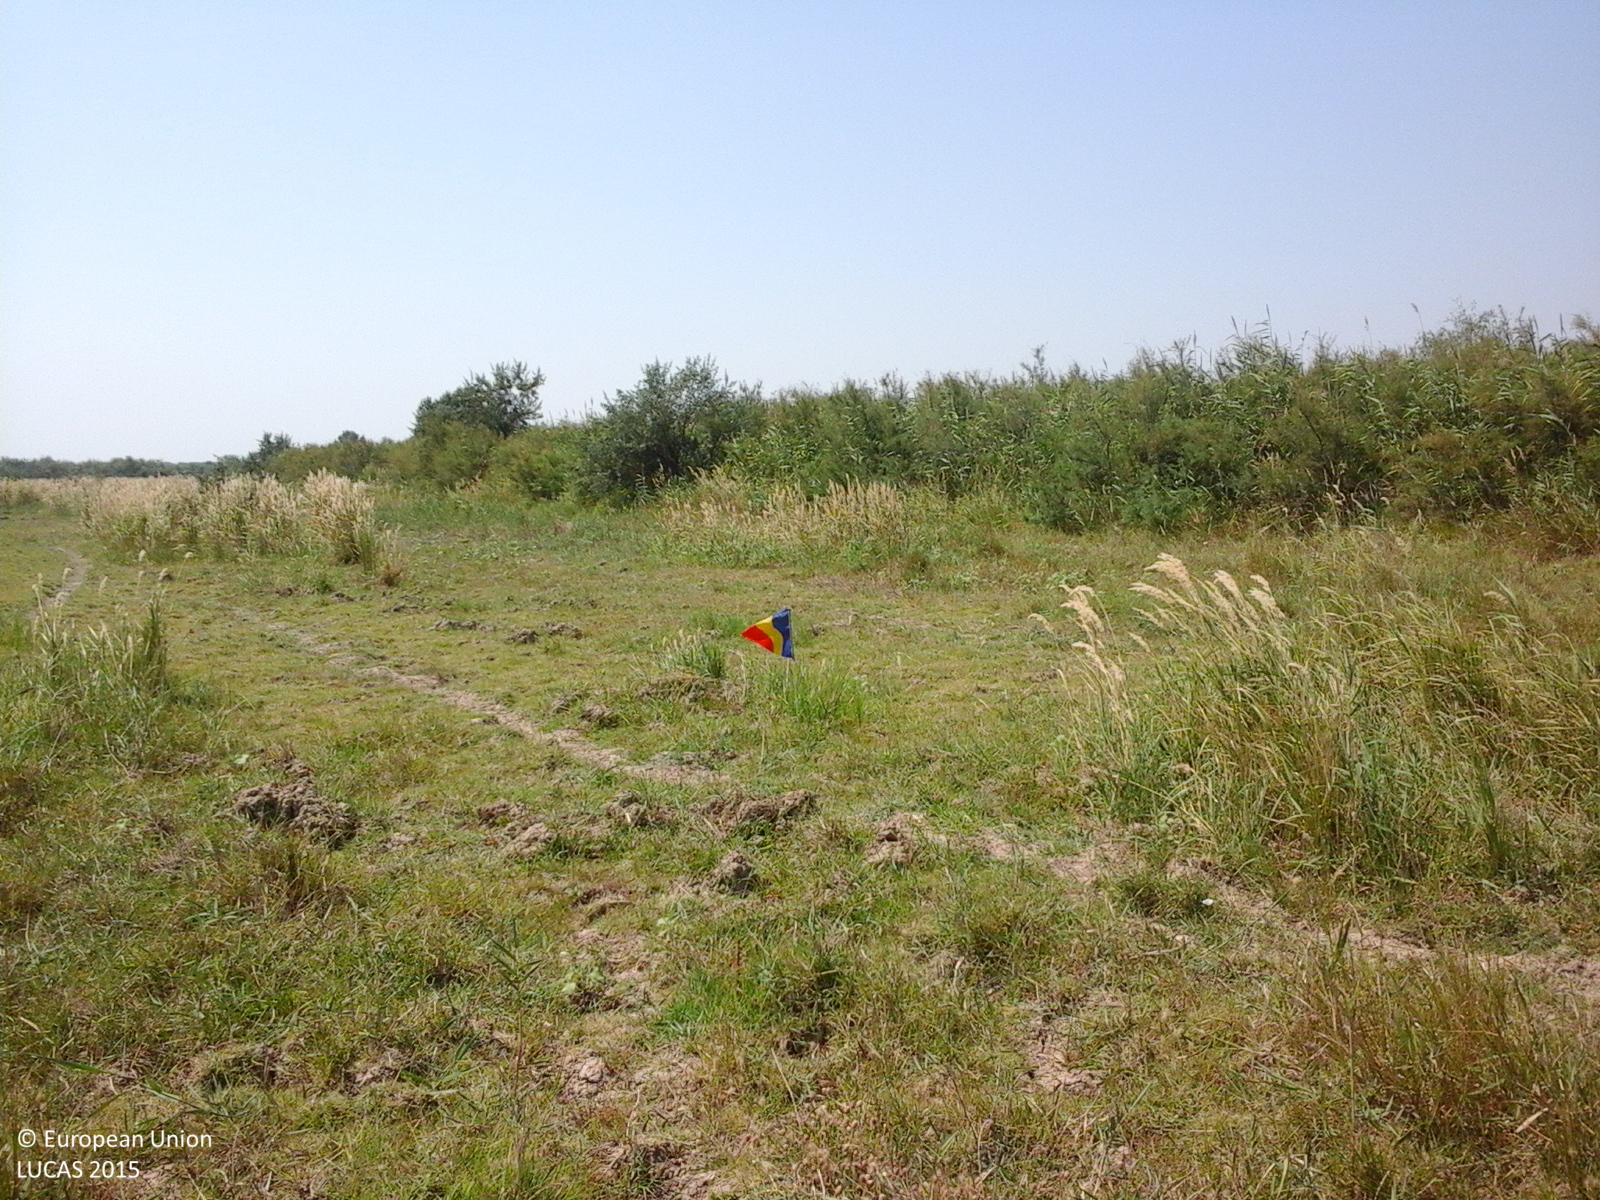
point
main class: Grassland
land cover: Spontaneously vegetated surfaces
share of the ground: > 75 %
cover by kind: herbaceous plants 100 %
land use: Agriculture (excluding fallow land and kitchen gardens)
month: August
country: RO
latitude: 45.2098
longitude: 27.3738
